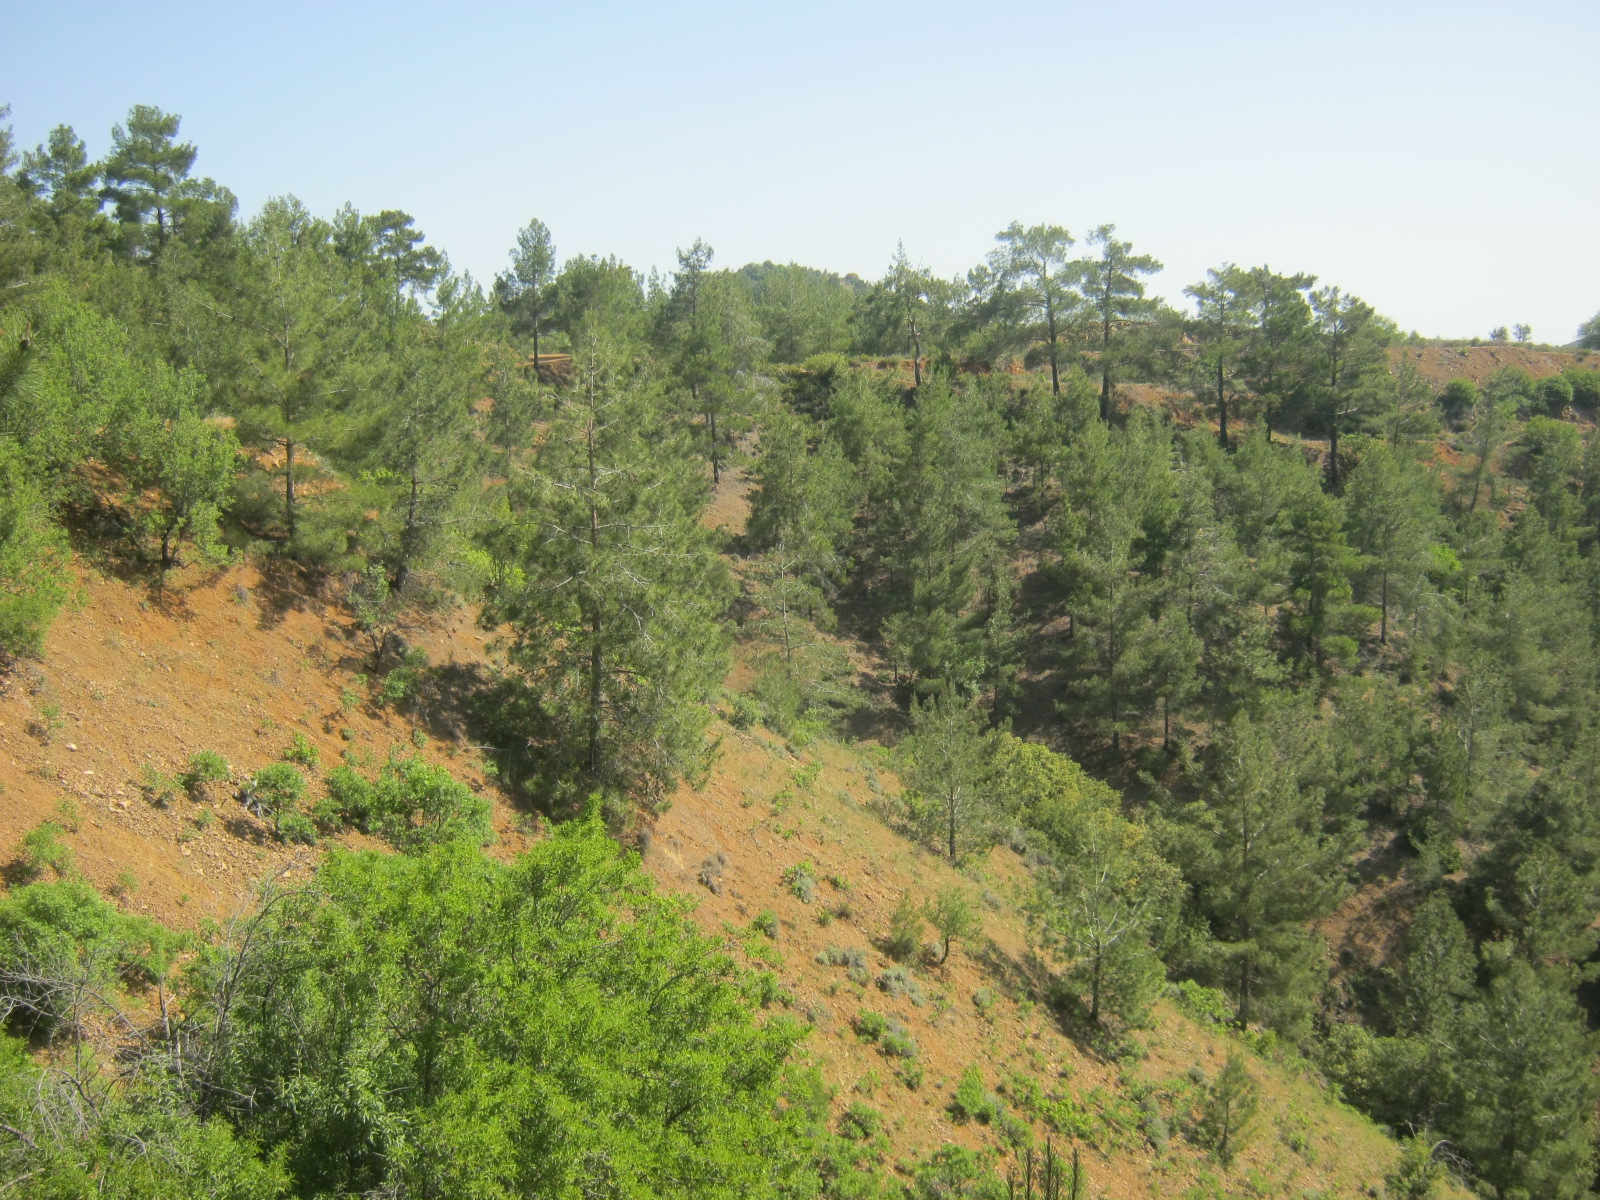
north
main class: Woodland
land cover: Pine dominated coniferous woodland
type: coniferous forest of the mediterranean region
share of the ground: 50 - 75 %
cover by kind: coniferous forest trees 60 %, shrubs 20 %, unconsolidated bare surface 20 %
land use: Forestry
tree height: > 5 m
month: May
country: CY
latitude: 35.0145
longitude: 32.7962
